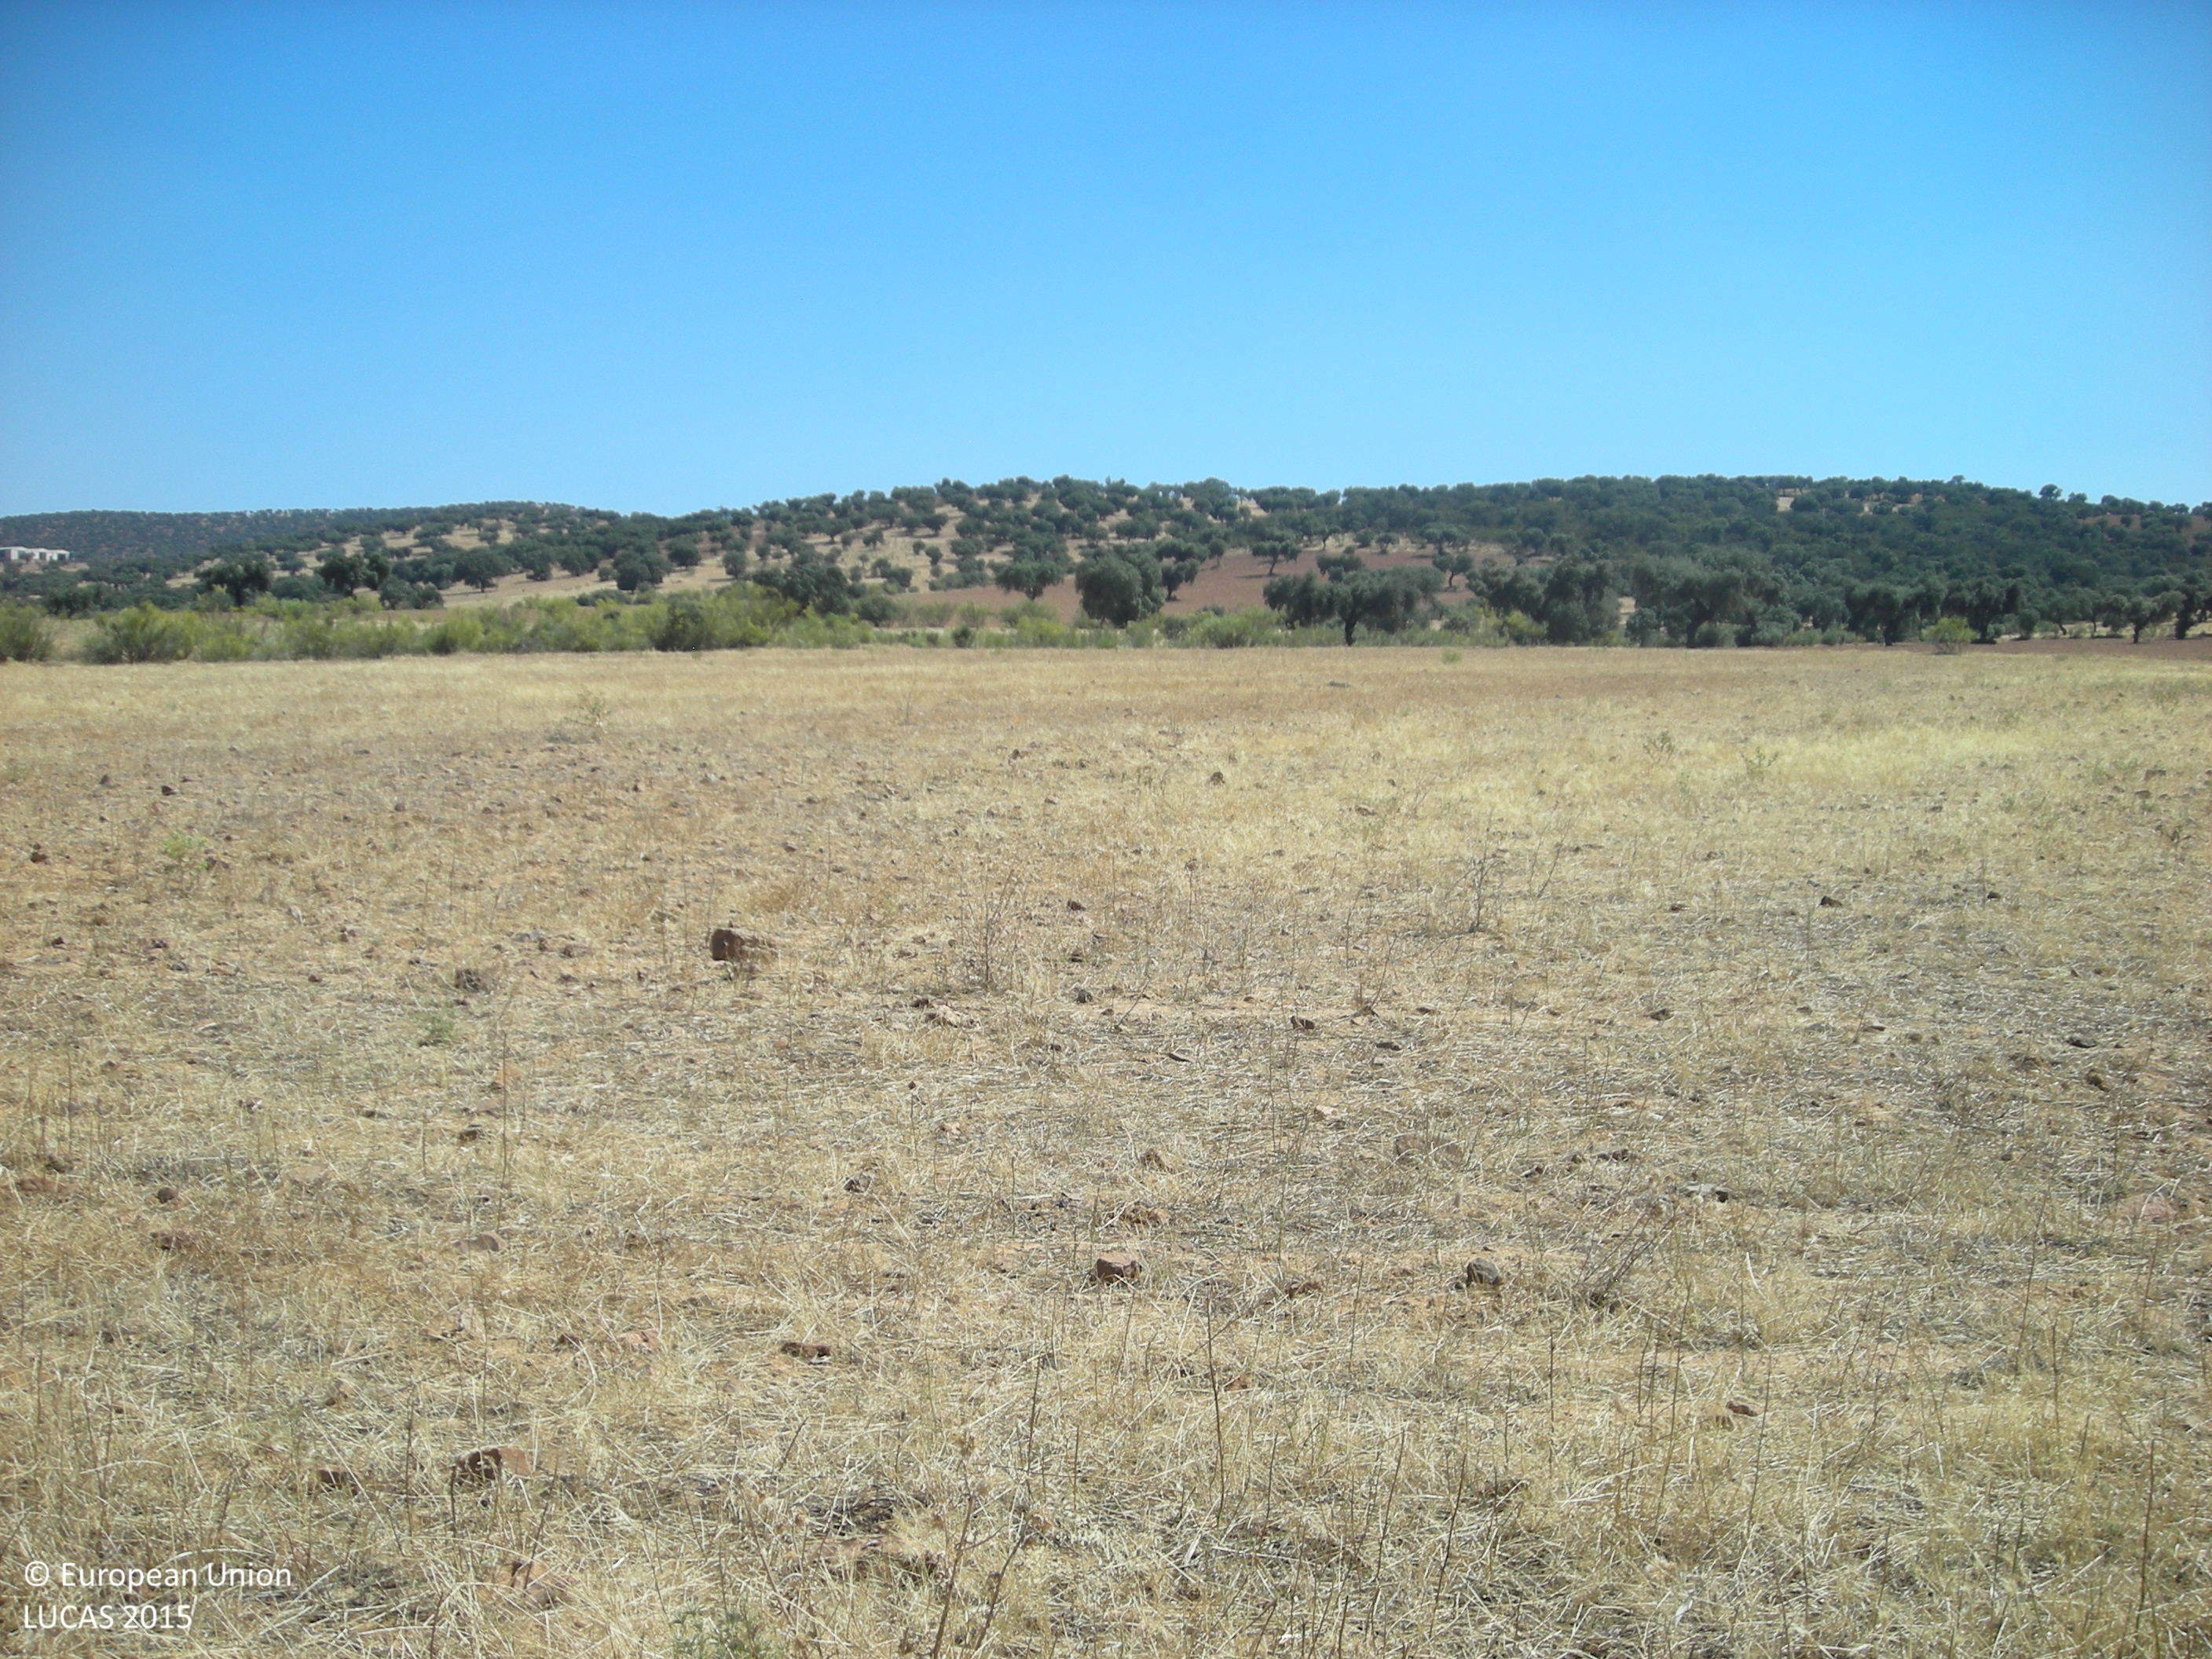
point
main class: Woodland
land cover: Broadleaved woodland
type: broadleaved evergreen forest
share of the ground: 25 - 50 %
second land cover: Grassland without tree/shrub cover
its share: 50 - 75 %
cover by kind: herbaceous plants 60 %, broadleaved forest trees 40 %
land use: Forestry
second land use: Agriculture (excluding fallow land and kitchen gardens)
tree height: > 5 m
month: June
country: ES
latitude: 38.6297
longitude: -5.7913
